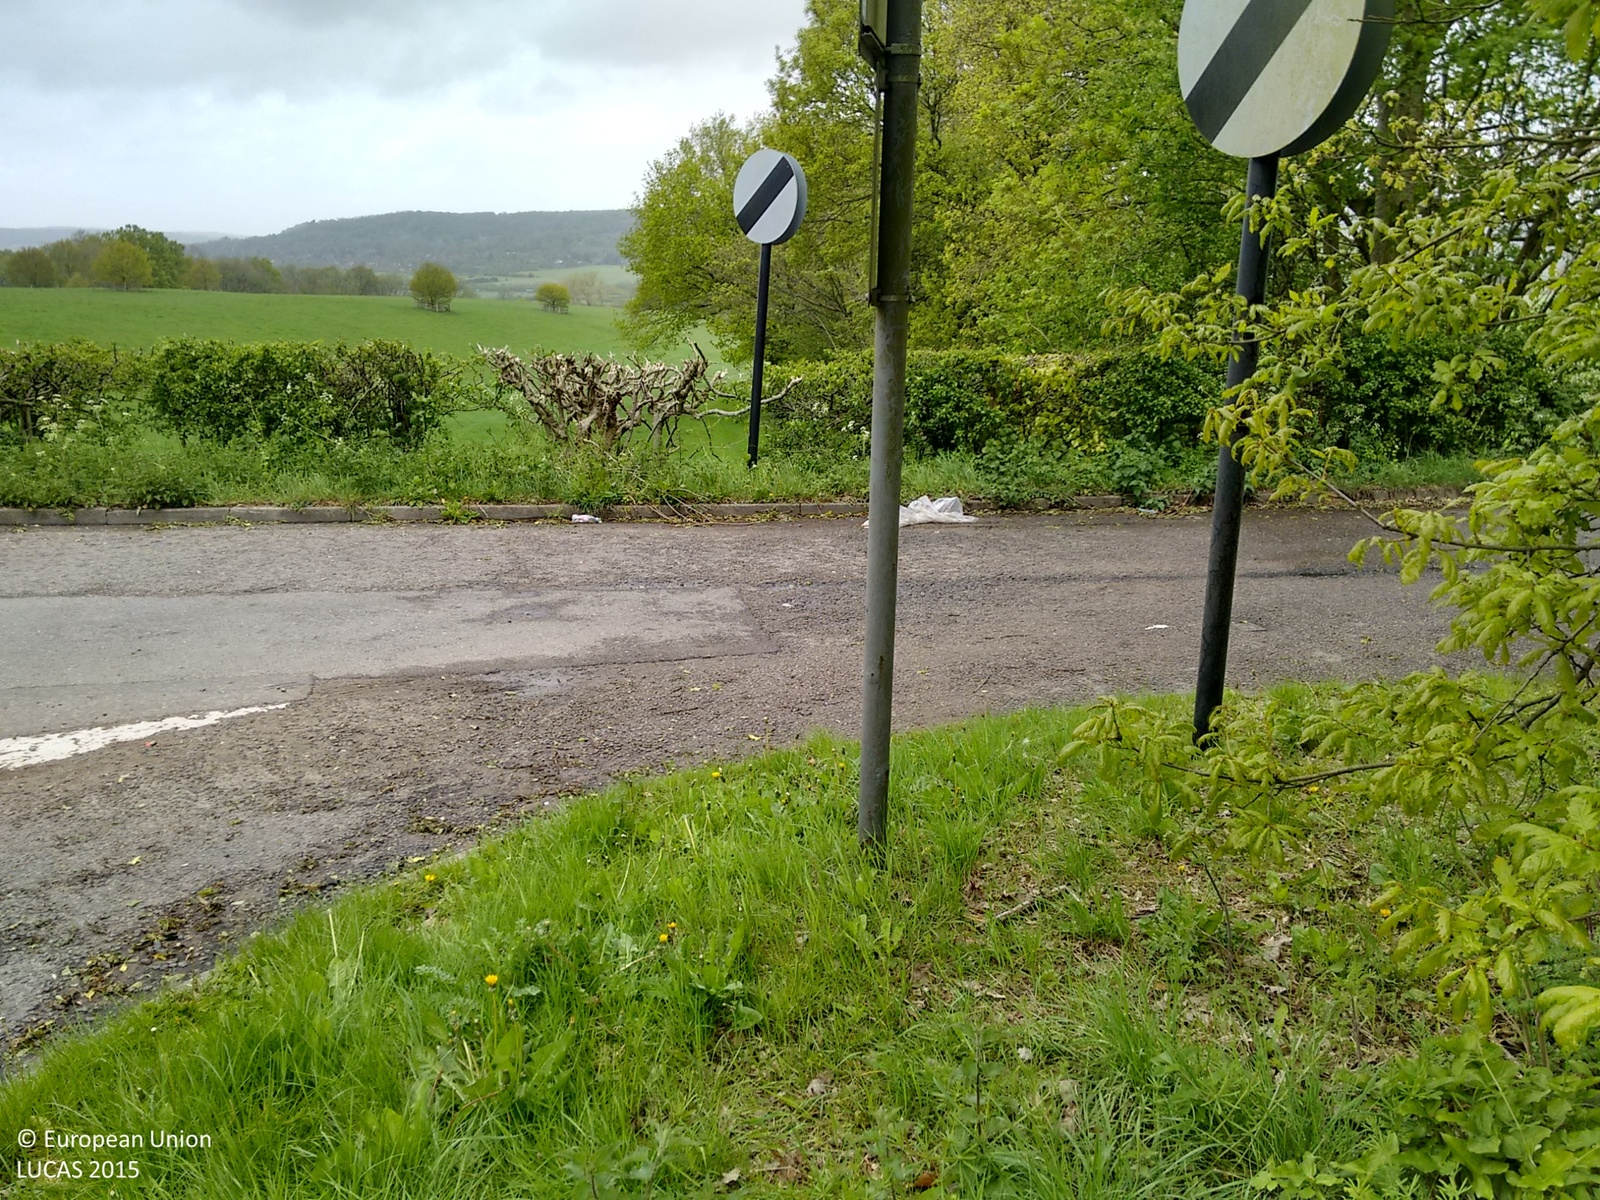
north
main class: Woodland
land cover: Broadleaved woodland
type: mesophytic deciduous forest
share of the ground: > 75 %
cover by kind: broadleaved forest trees 80 %, shrubs 20 %
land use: Forestry
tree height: > 5 m
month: May
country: GB
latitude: 51.2856
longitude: 0.2339
